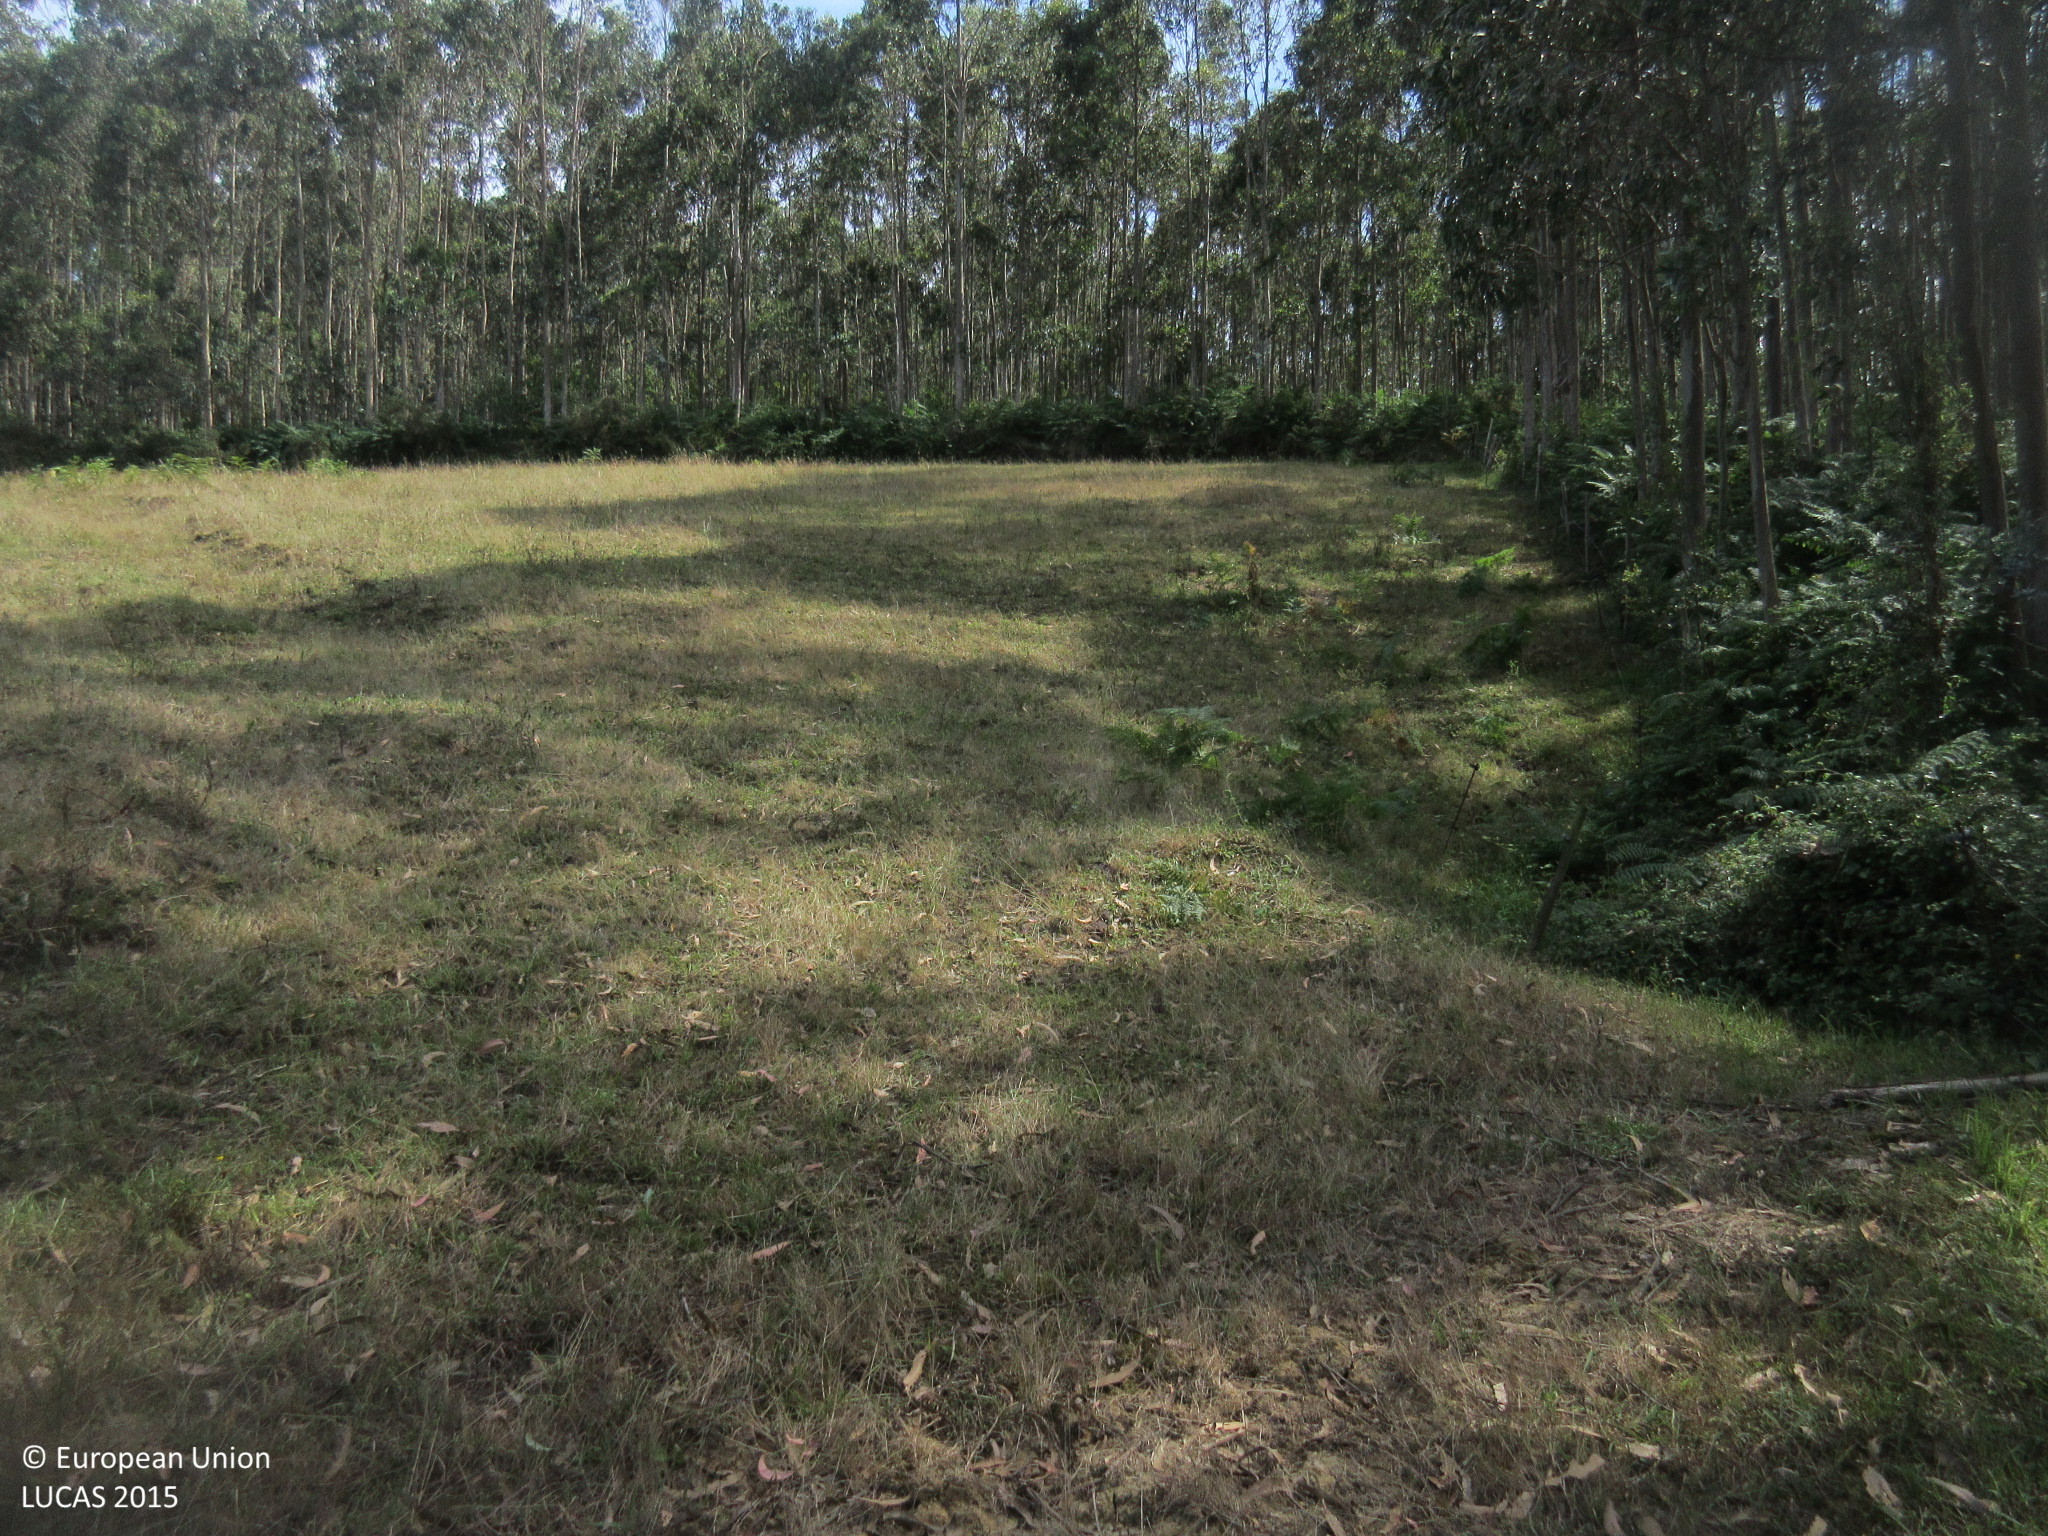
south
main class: Shrubland
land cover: Shrubland with sparse tree cover
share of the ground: > 75 %
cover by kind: shrubs 95 %, broadleaved forest trees 5 %
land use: Forestry
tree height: < 5 m
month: July
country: ES
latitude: 43.3812
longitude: -4.2382
